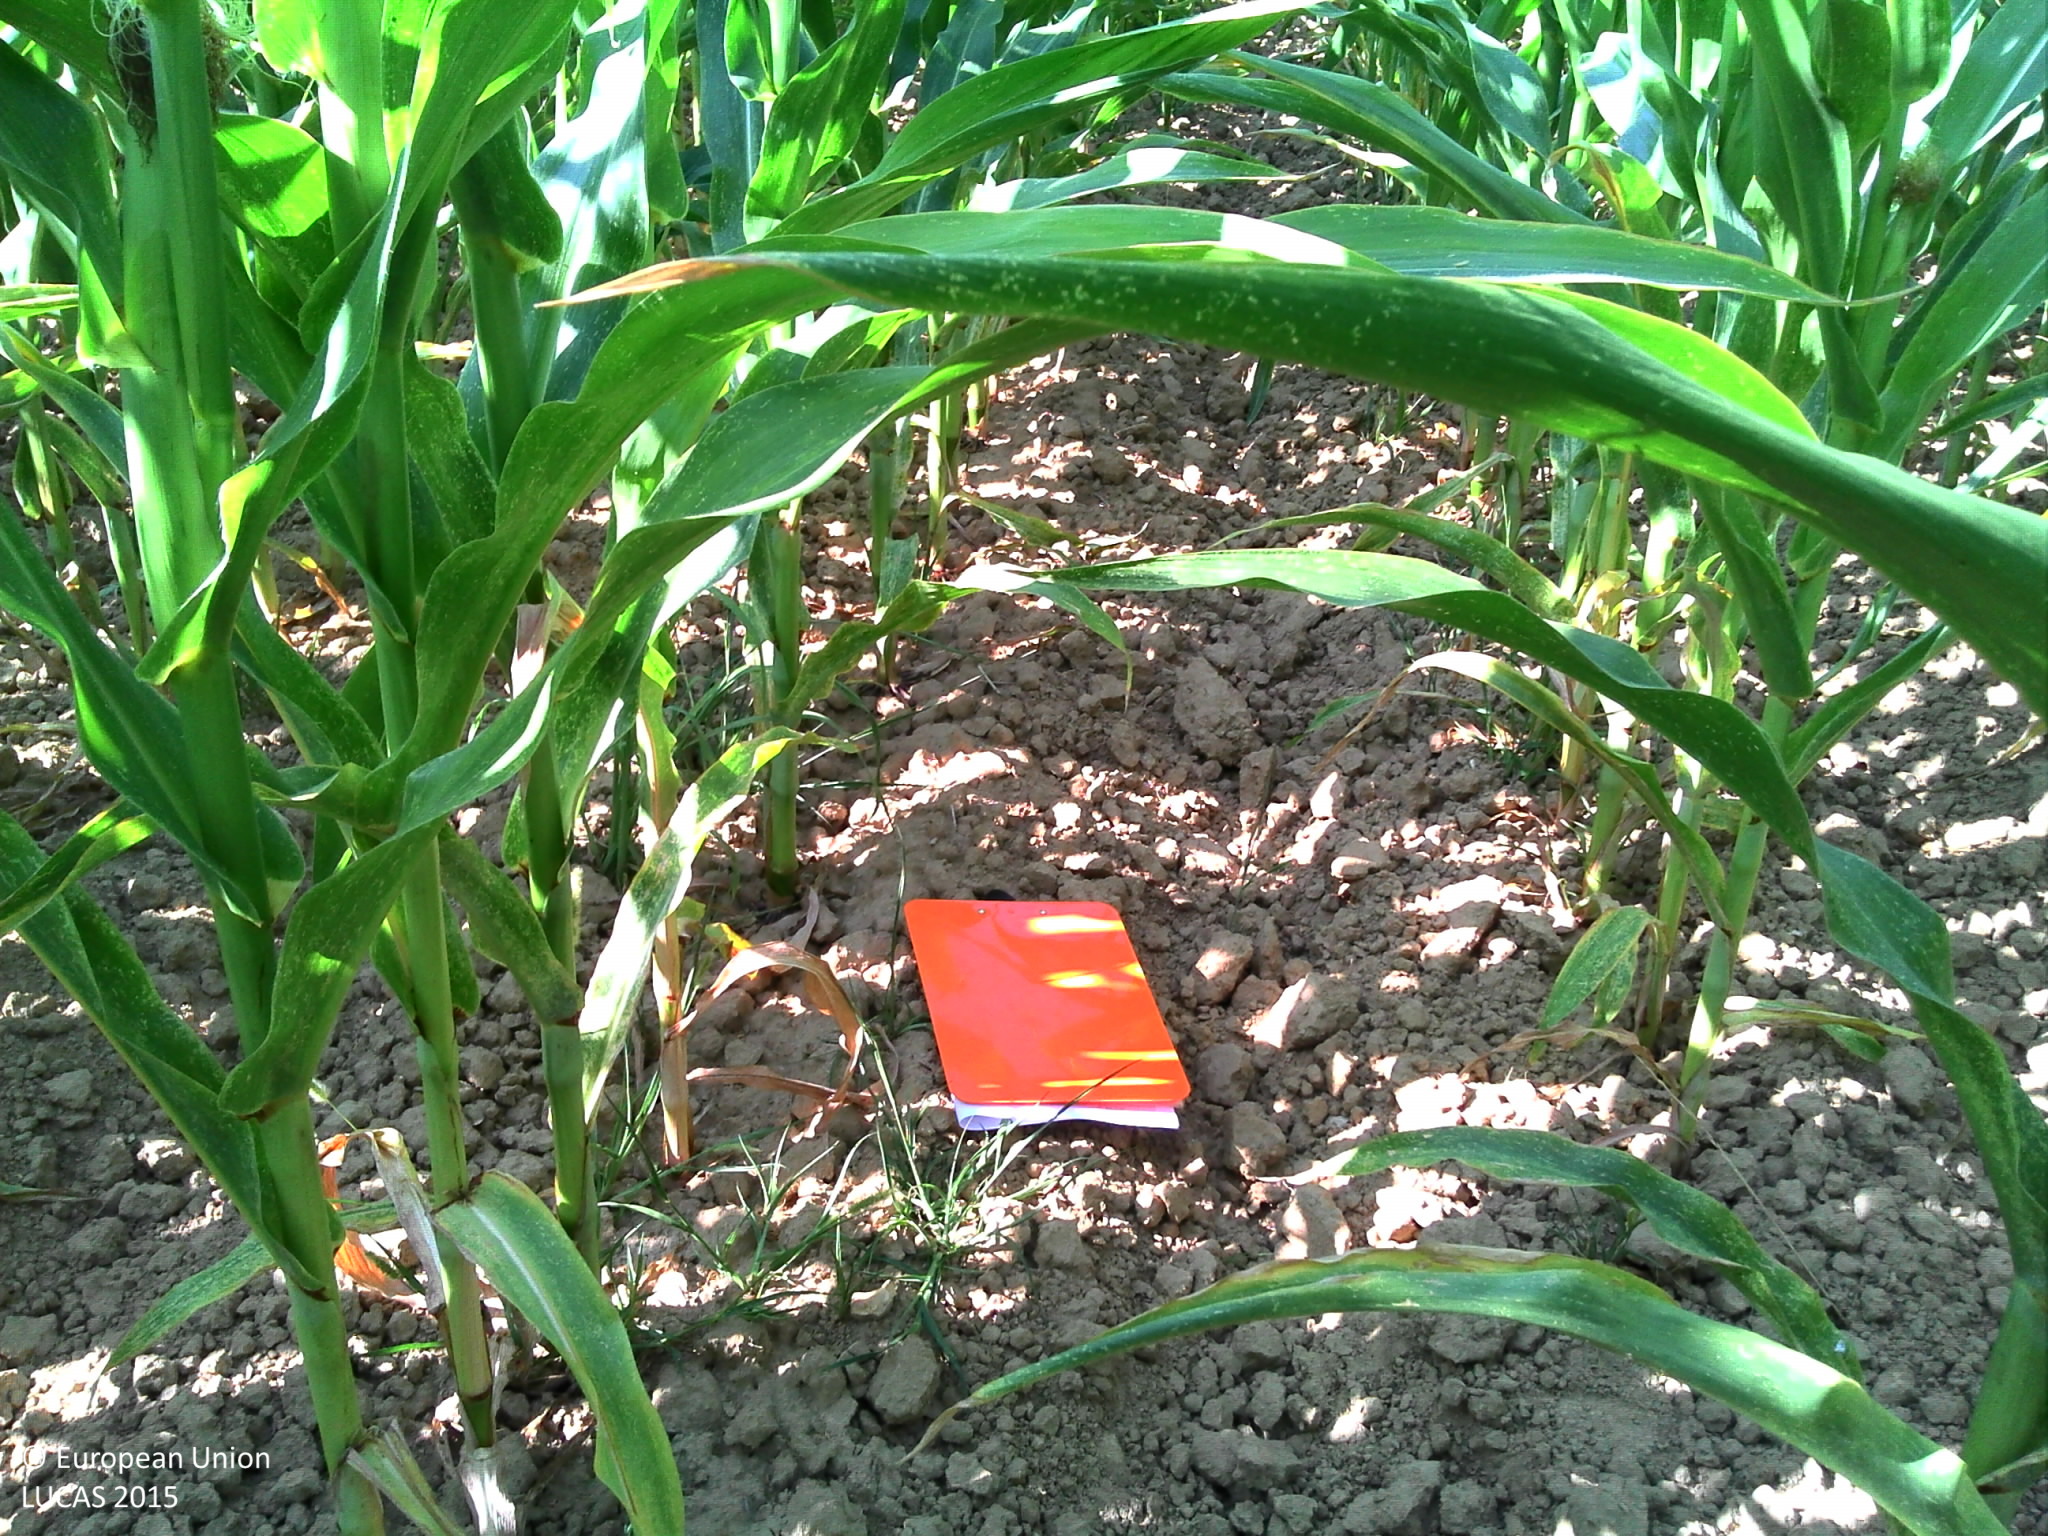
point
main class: Cropland
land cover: Maize
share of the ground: > 75 %
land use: Agriculture (excluding fallow land and kitchen gardens)
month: August
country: FR
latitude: 44.7950
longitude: 1.2352
